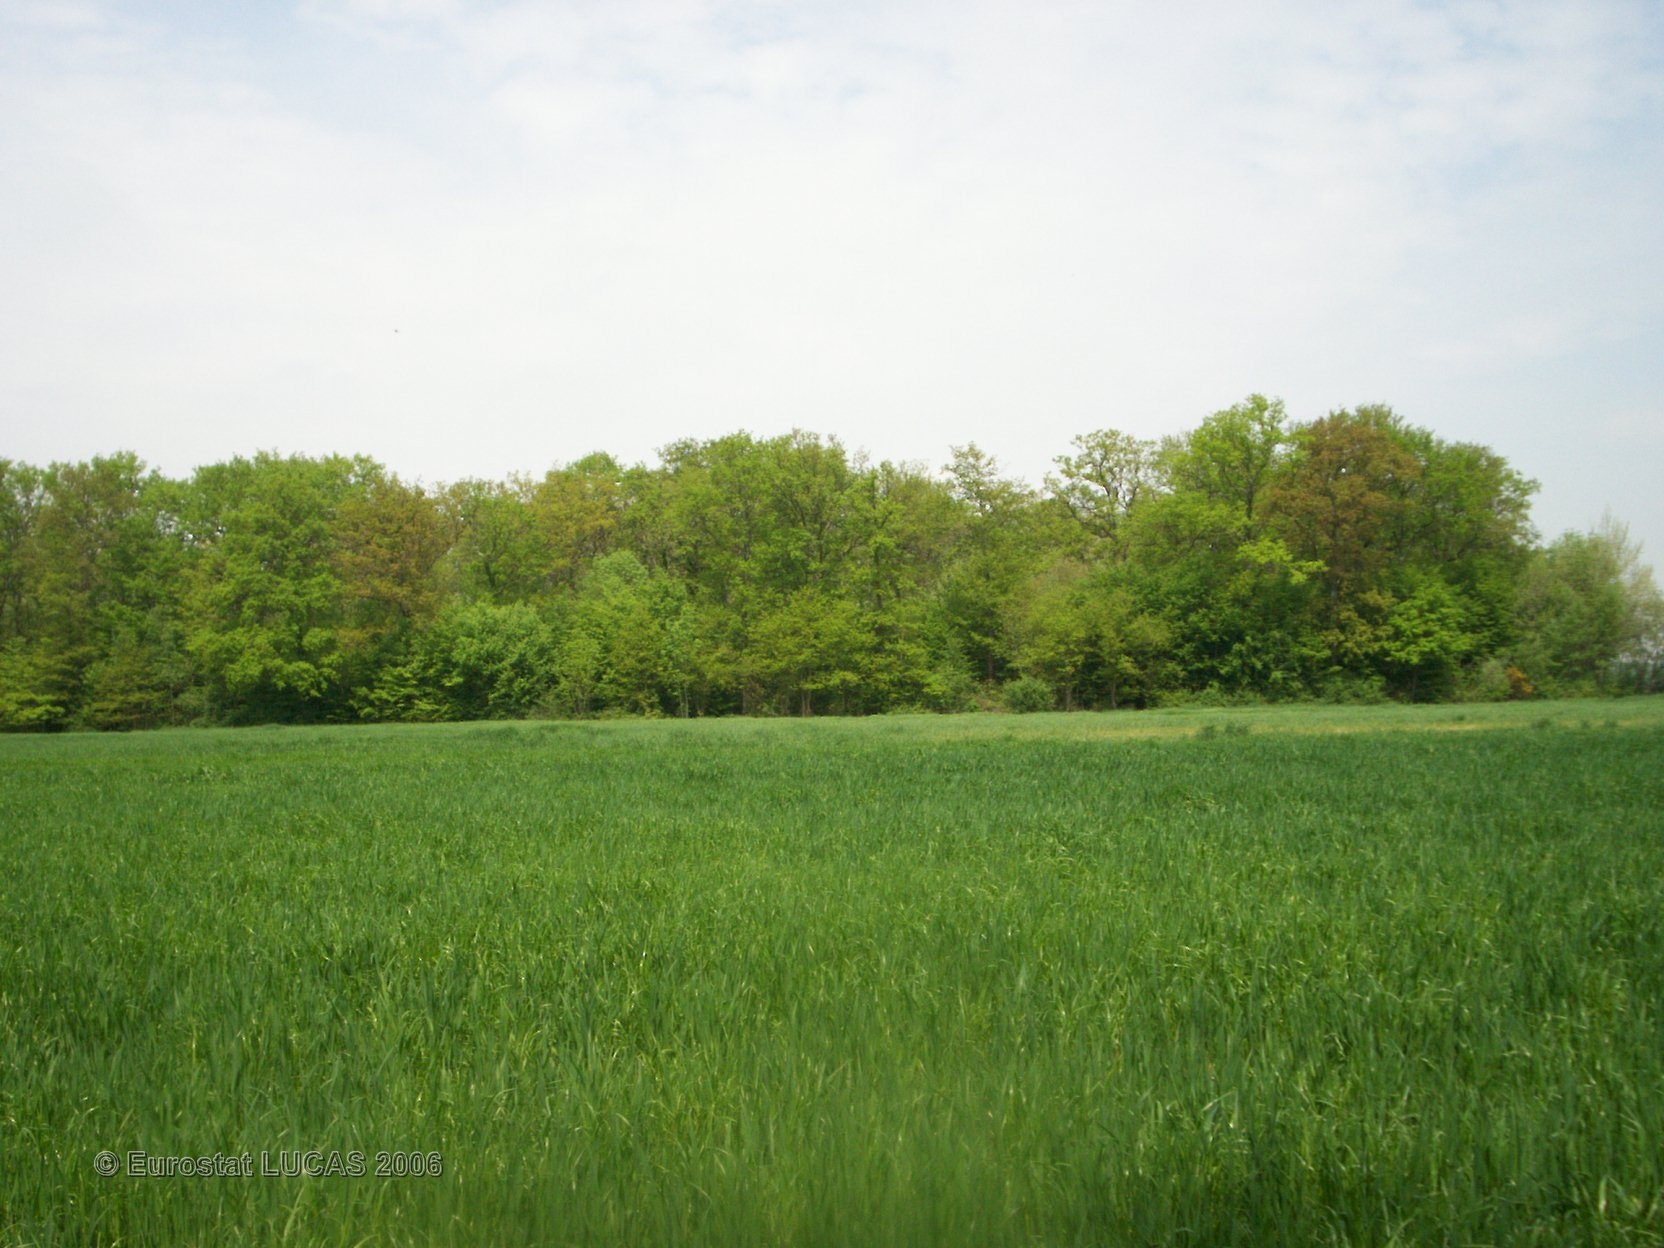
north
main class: Cropland
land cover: Barley
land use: Agriculture (excluding fallow land and kitchen gardens)
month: May
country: FR
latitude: 47.8745
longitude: 3.0006
